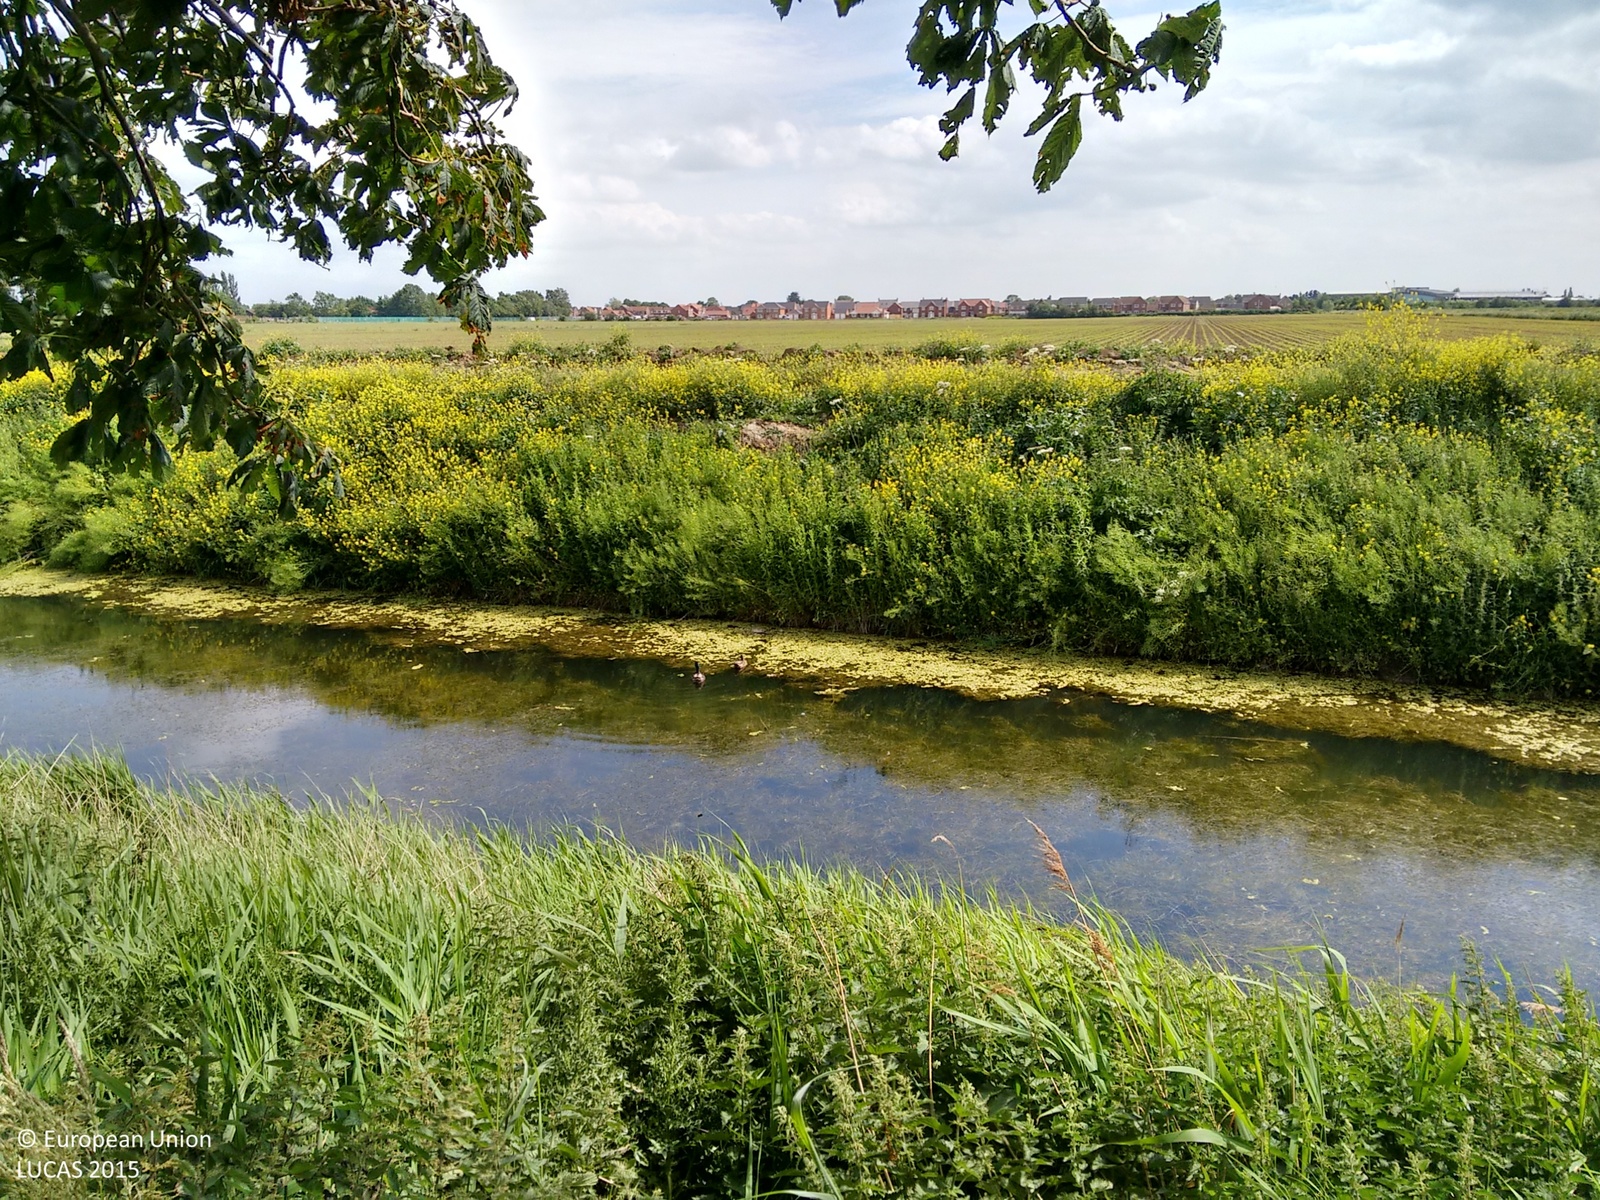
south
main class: Cropland
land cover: Maize
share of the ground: 25 - 50 %
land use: Agriculture (excluding fallow land and kitchen gardens)
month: June
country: GB
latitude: 52.9823
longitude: -0.0568
